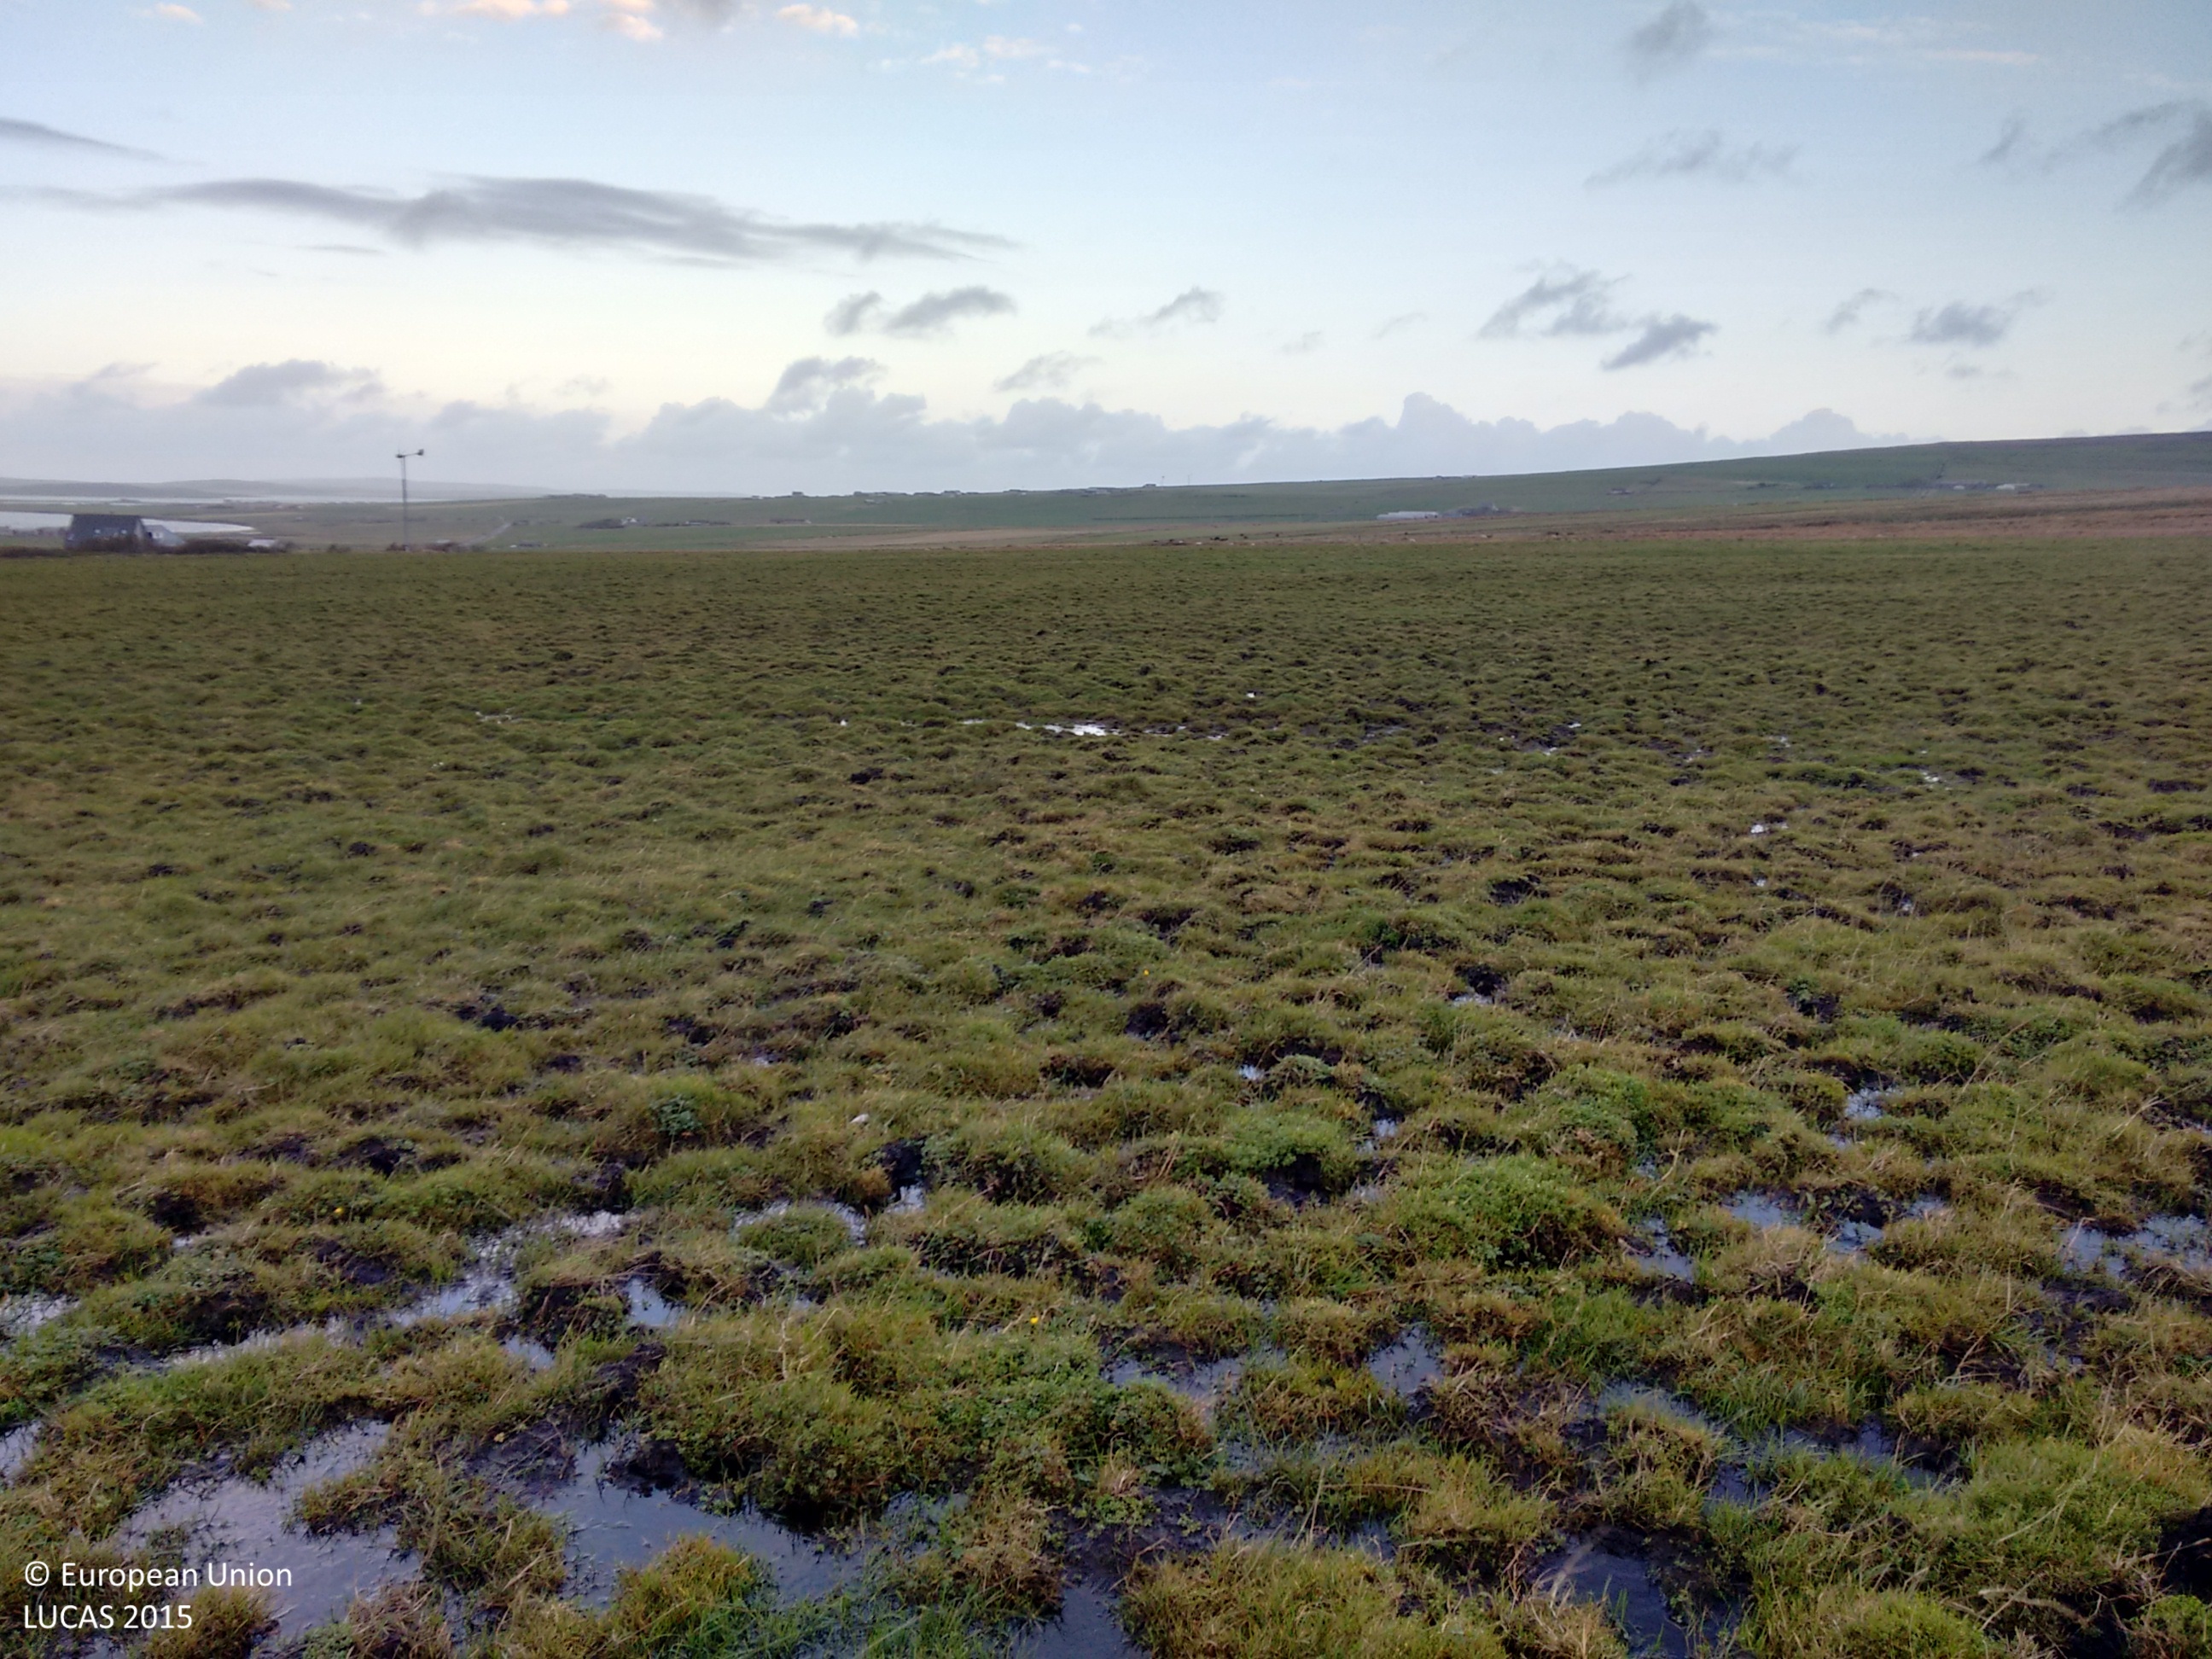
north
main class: Grassland
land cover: Grassland without tree/shrub cover
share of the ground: > 75 %
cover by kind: herbaceous plants 70 %, unconsolidated bare surface 30 %
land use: Agriculture (excluding fallow land and kitchen gardens)
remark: Temporary flooded
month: November
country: GB
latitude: 58.9518
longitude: -3.2155
